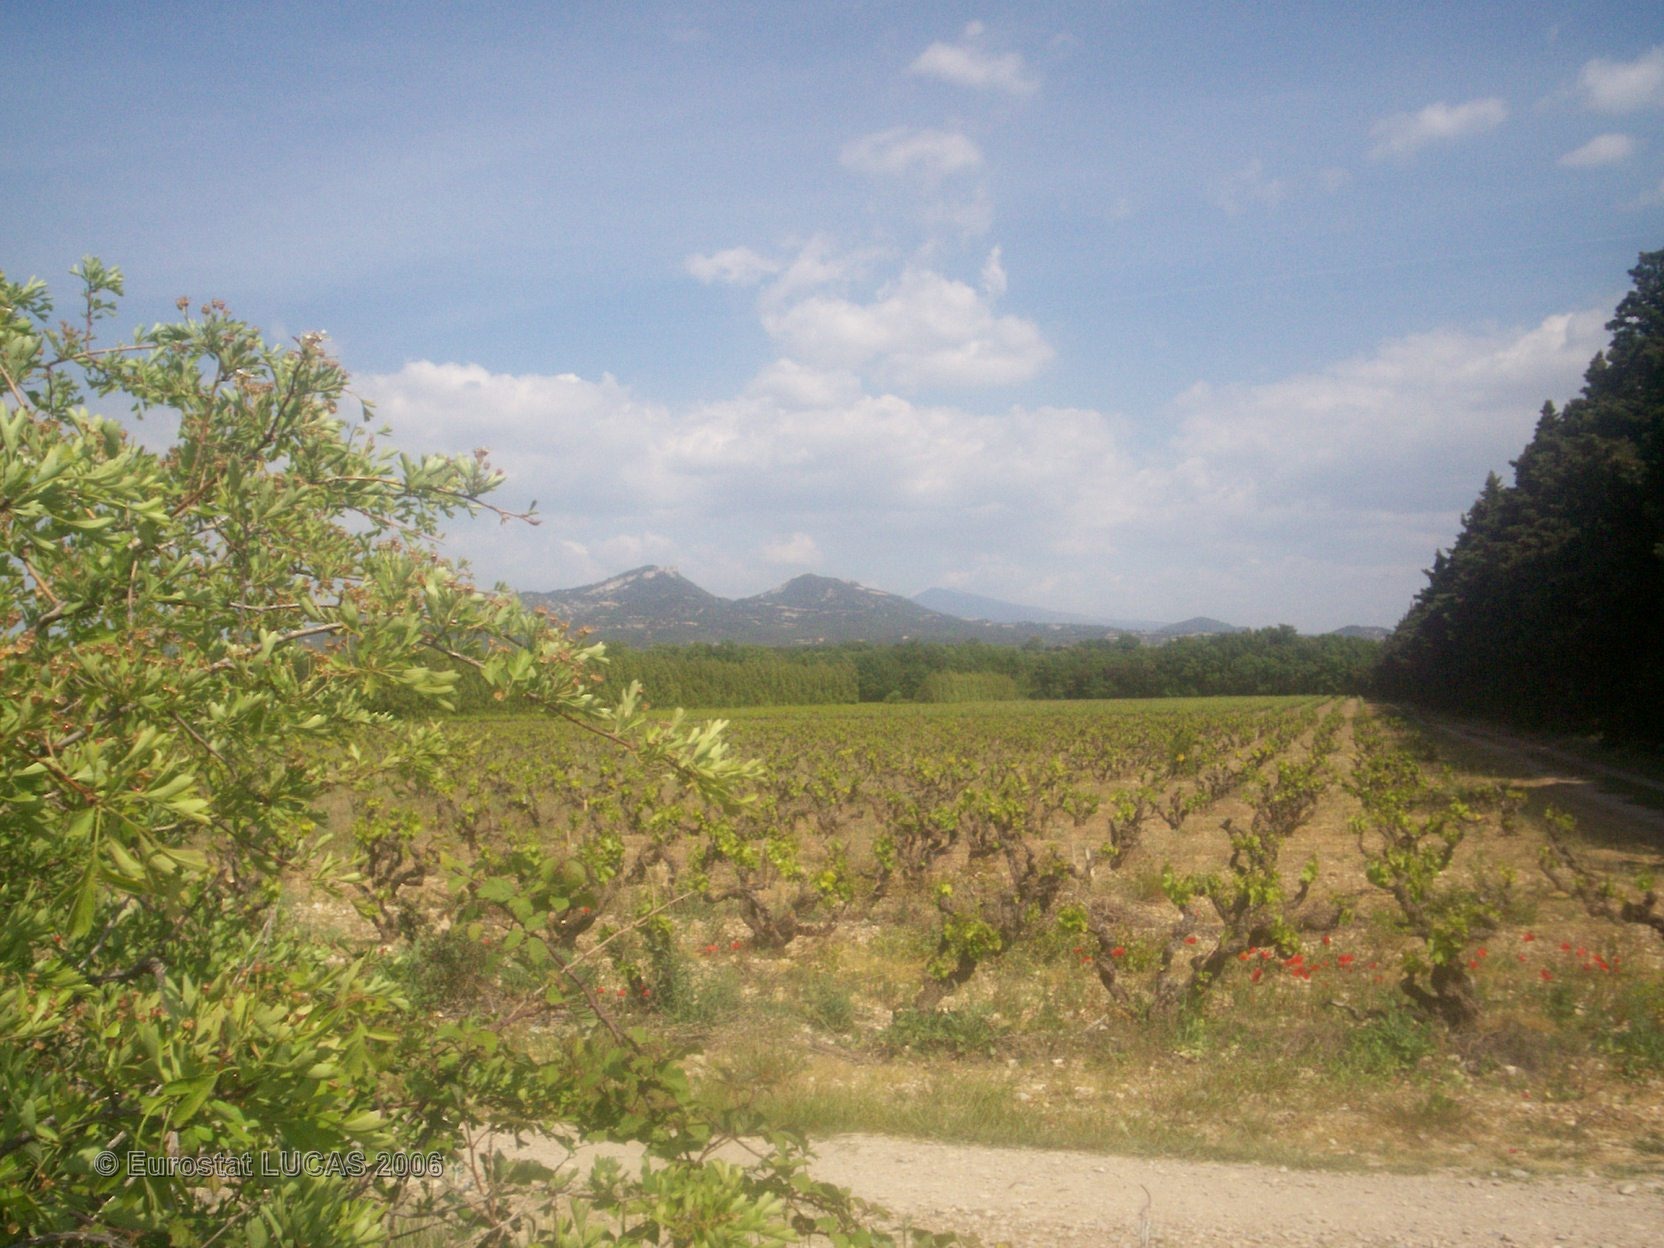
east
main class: Grassland
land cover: Grassland without tree/shrub cover
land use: Agriculture (excluding fallow land and kitchen gardens)
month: June
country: FR
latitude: 44.1371
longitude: 4.9456
